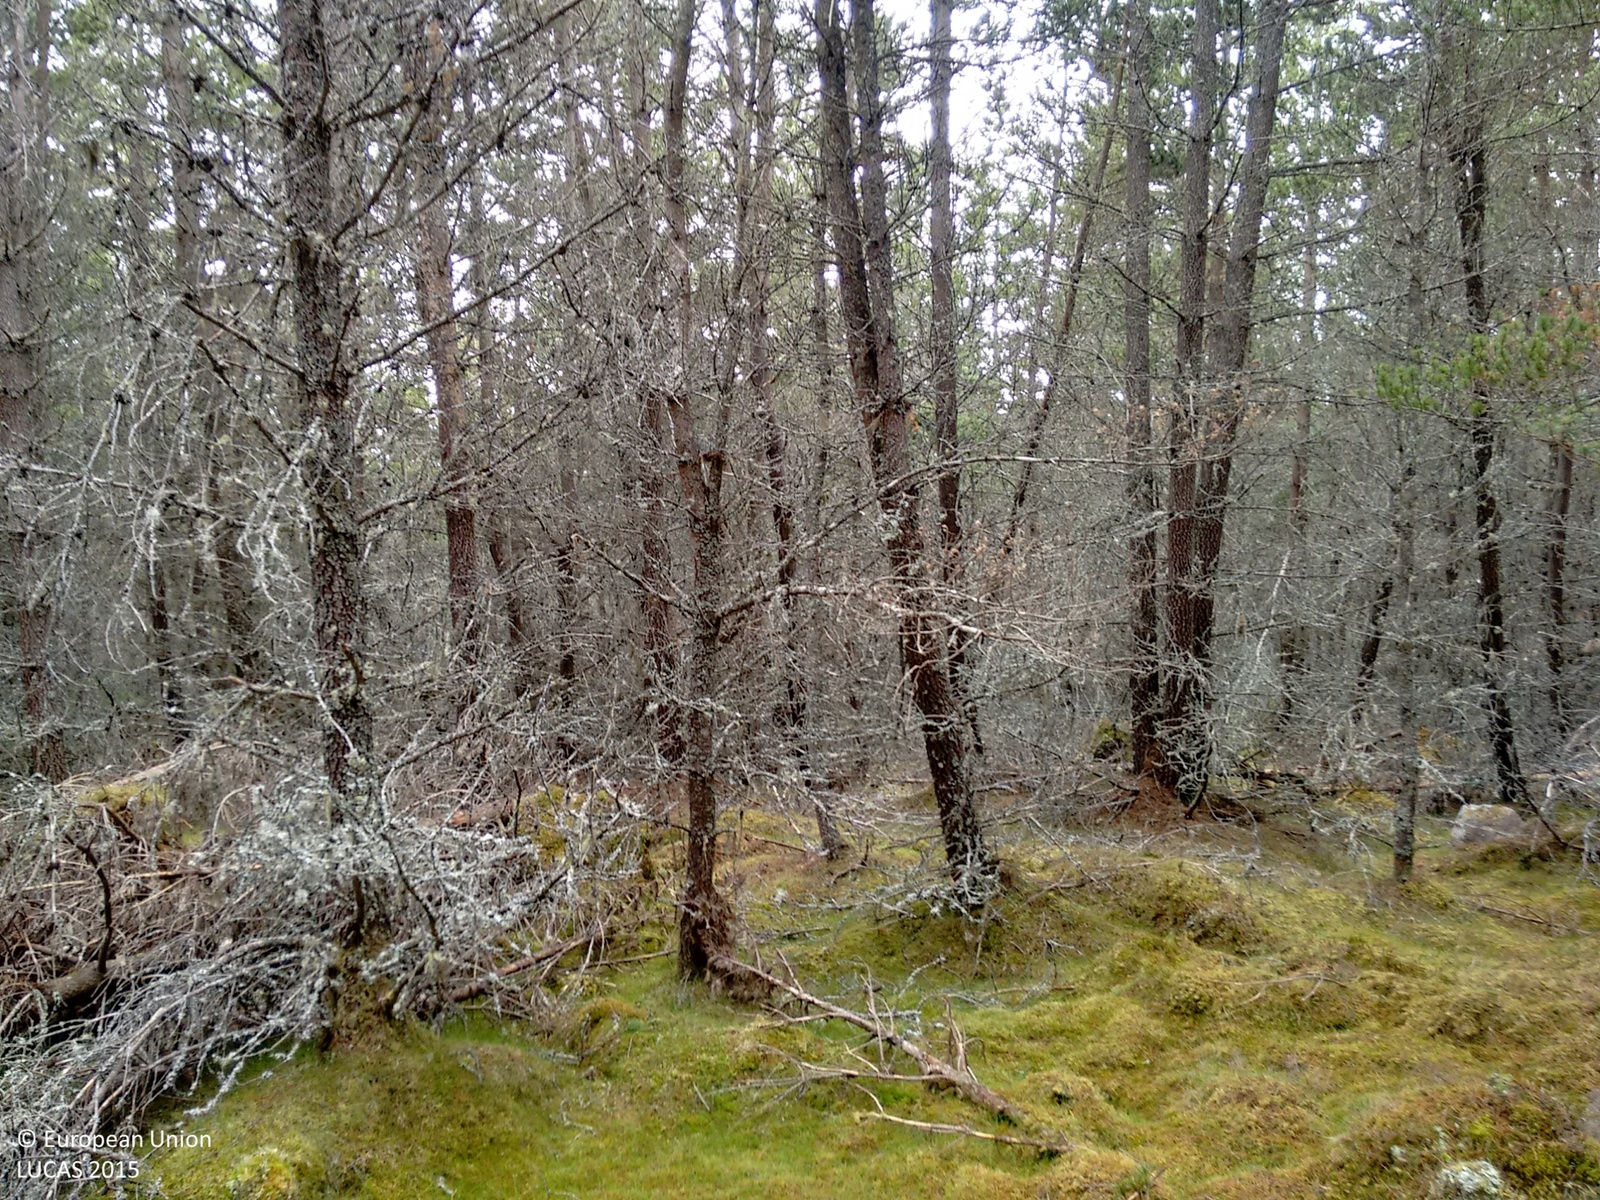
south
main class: Woodland
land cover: Pine dominated coniferous woodland
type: exotic forest
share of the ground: 50 - 75 %
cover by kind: coniferous forest trees 60 %, lichens and mosses 40 %
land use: Forestry
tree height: > 5 m
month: June
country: GB
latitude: 57.2768
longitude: -3.8617
